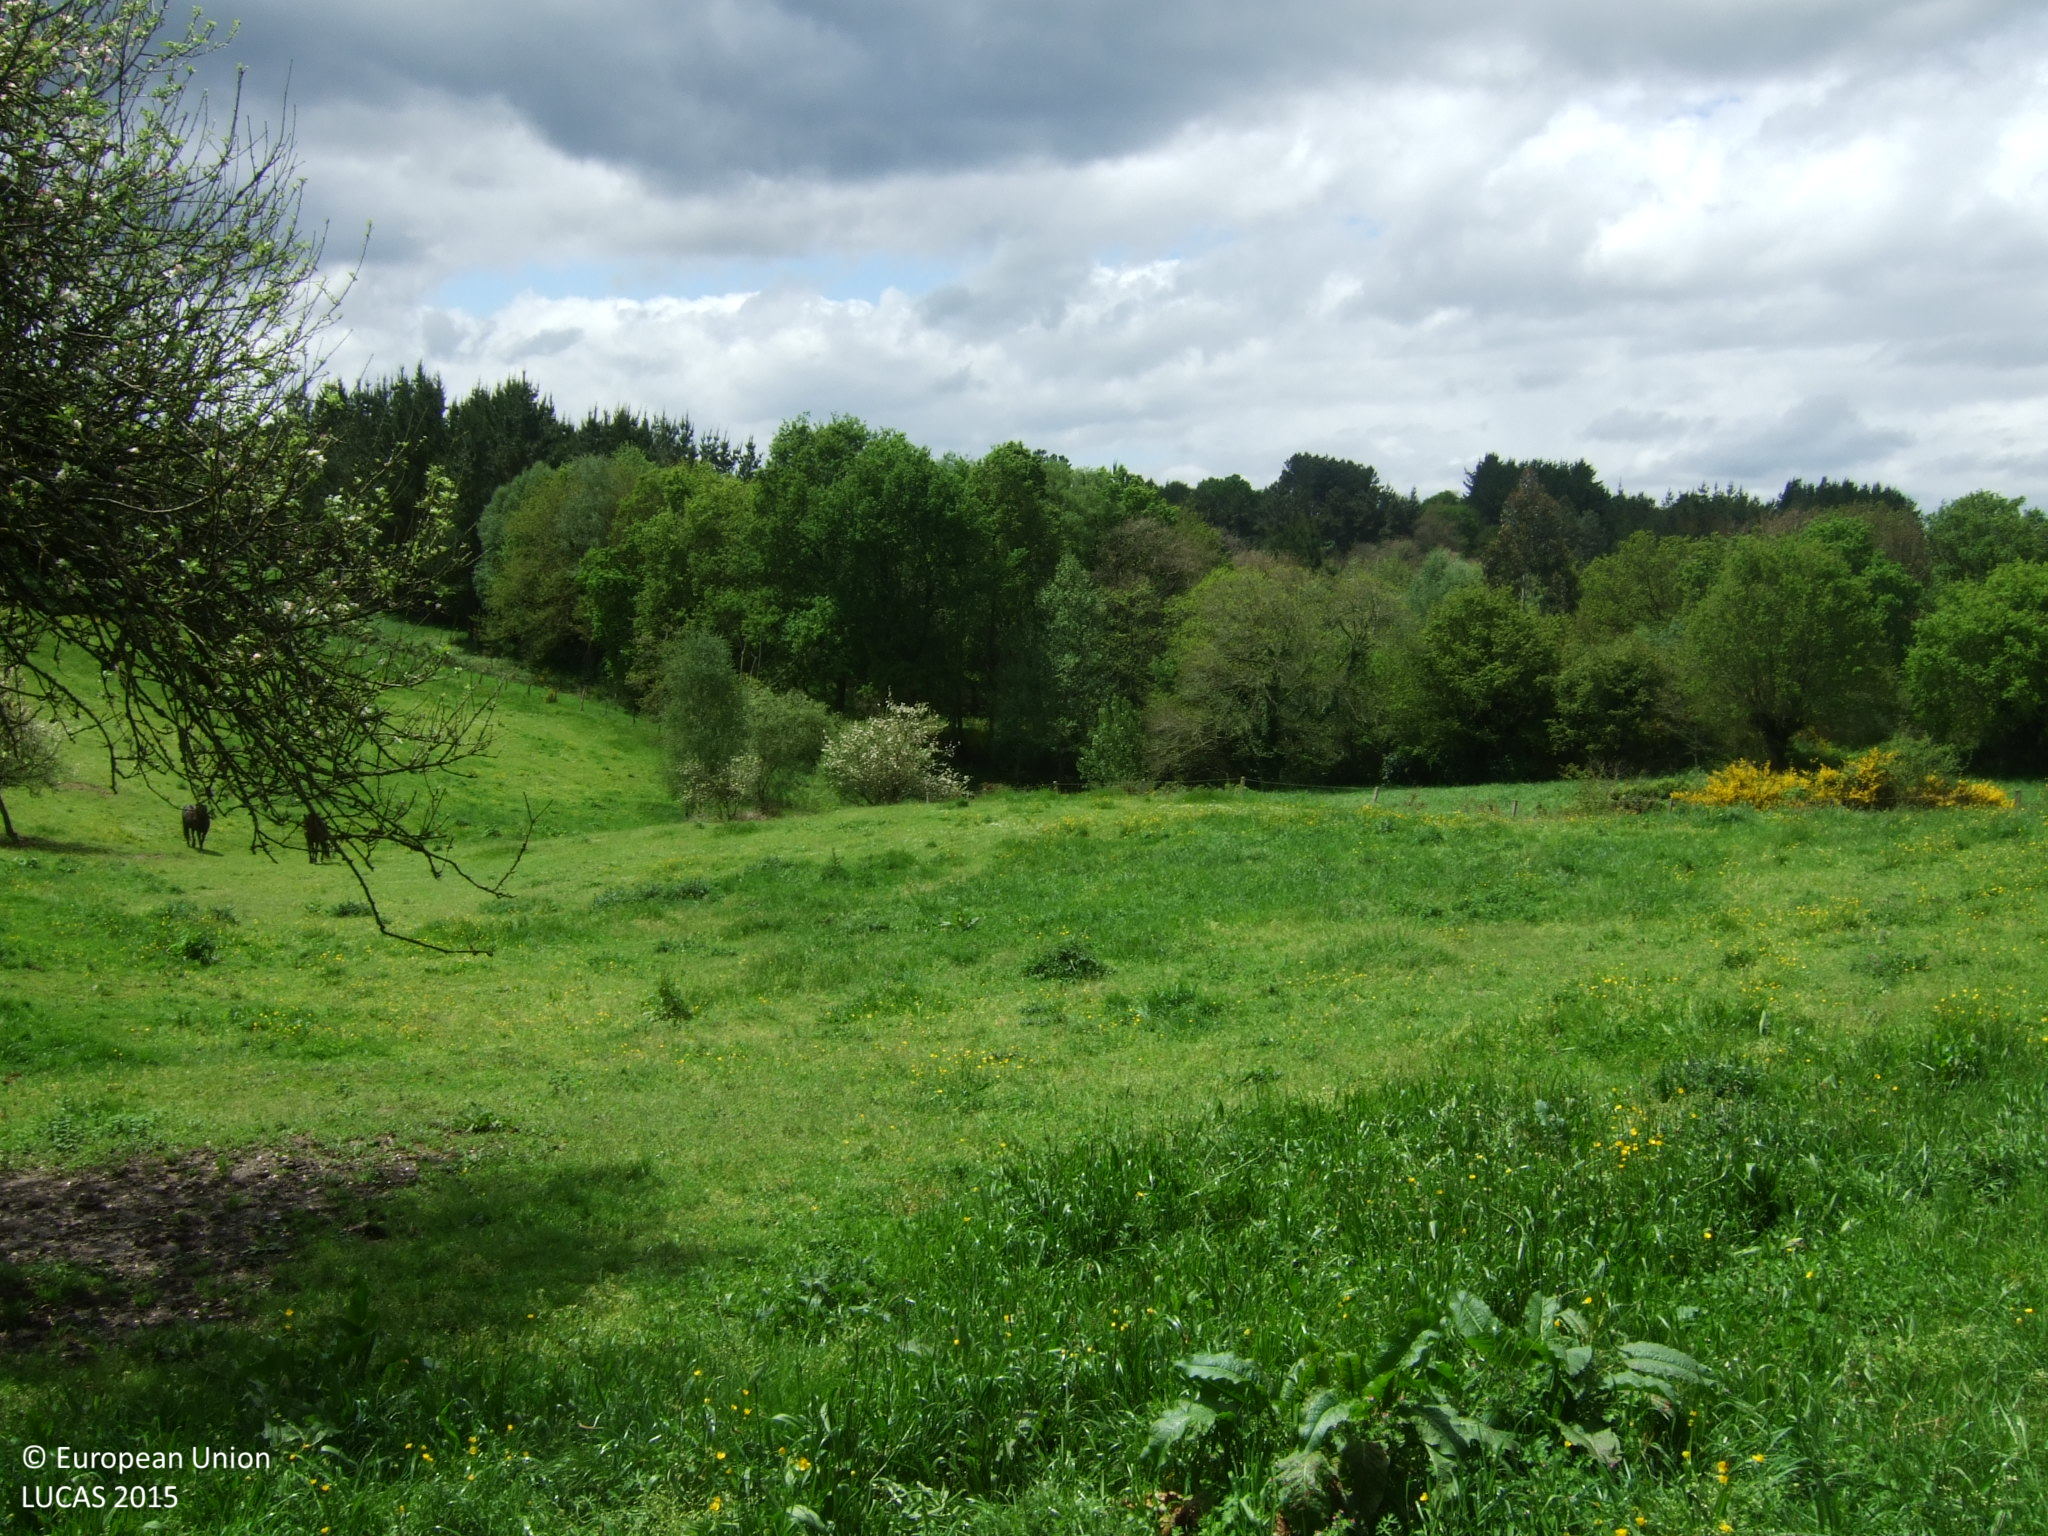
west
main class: Grassland
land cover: Grassland without tree/shrub cover
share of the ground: > 75 %
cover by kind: herbaceous plants 100 %
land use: Agriculture (excluding fallow land and kitchen gardens)
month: May
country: ES
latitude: 42.7997
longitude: -7.5720
